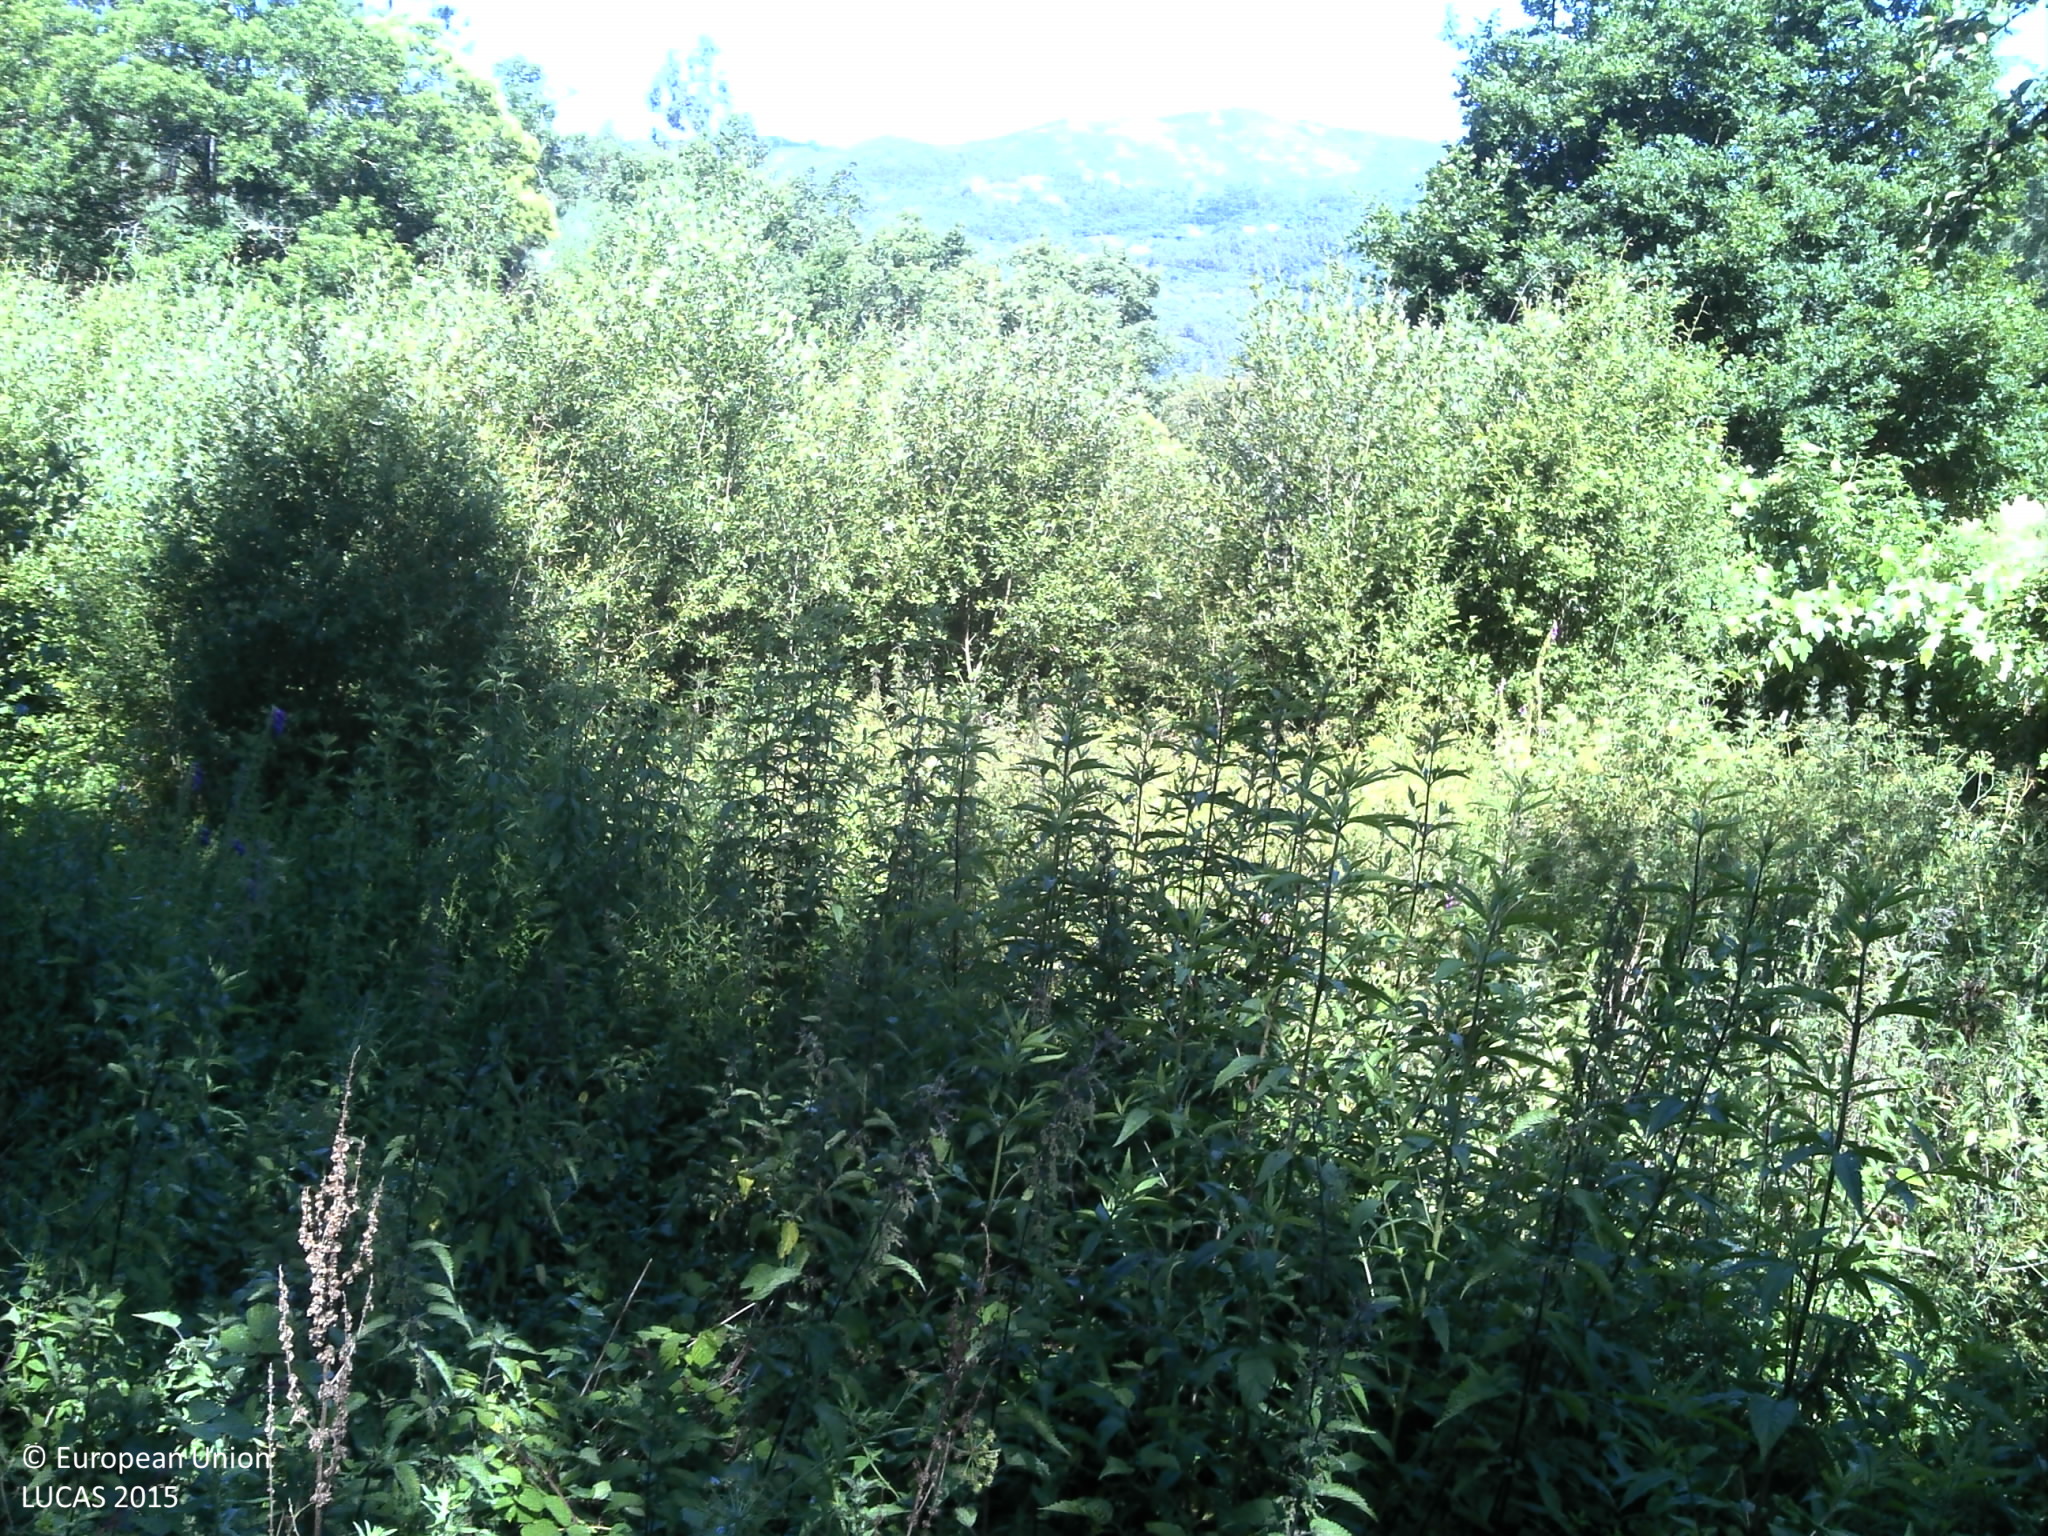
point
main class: Shrubland
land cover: Shrubland without tree cover
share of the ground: > 75 %
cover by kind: shrubs 90 %, unconsolidated bare surface 10 %
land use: Semi-natural and natural areas not in use
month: June
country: PT
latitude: 40.8755
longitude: -8.0132
